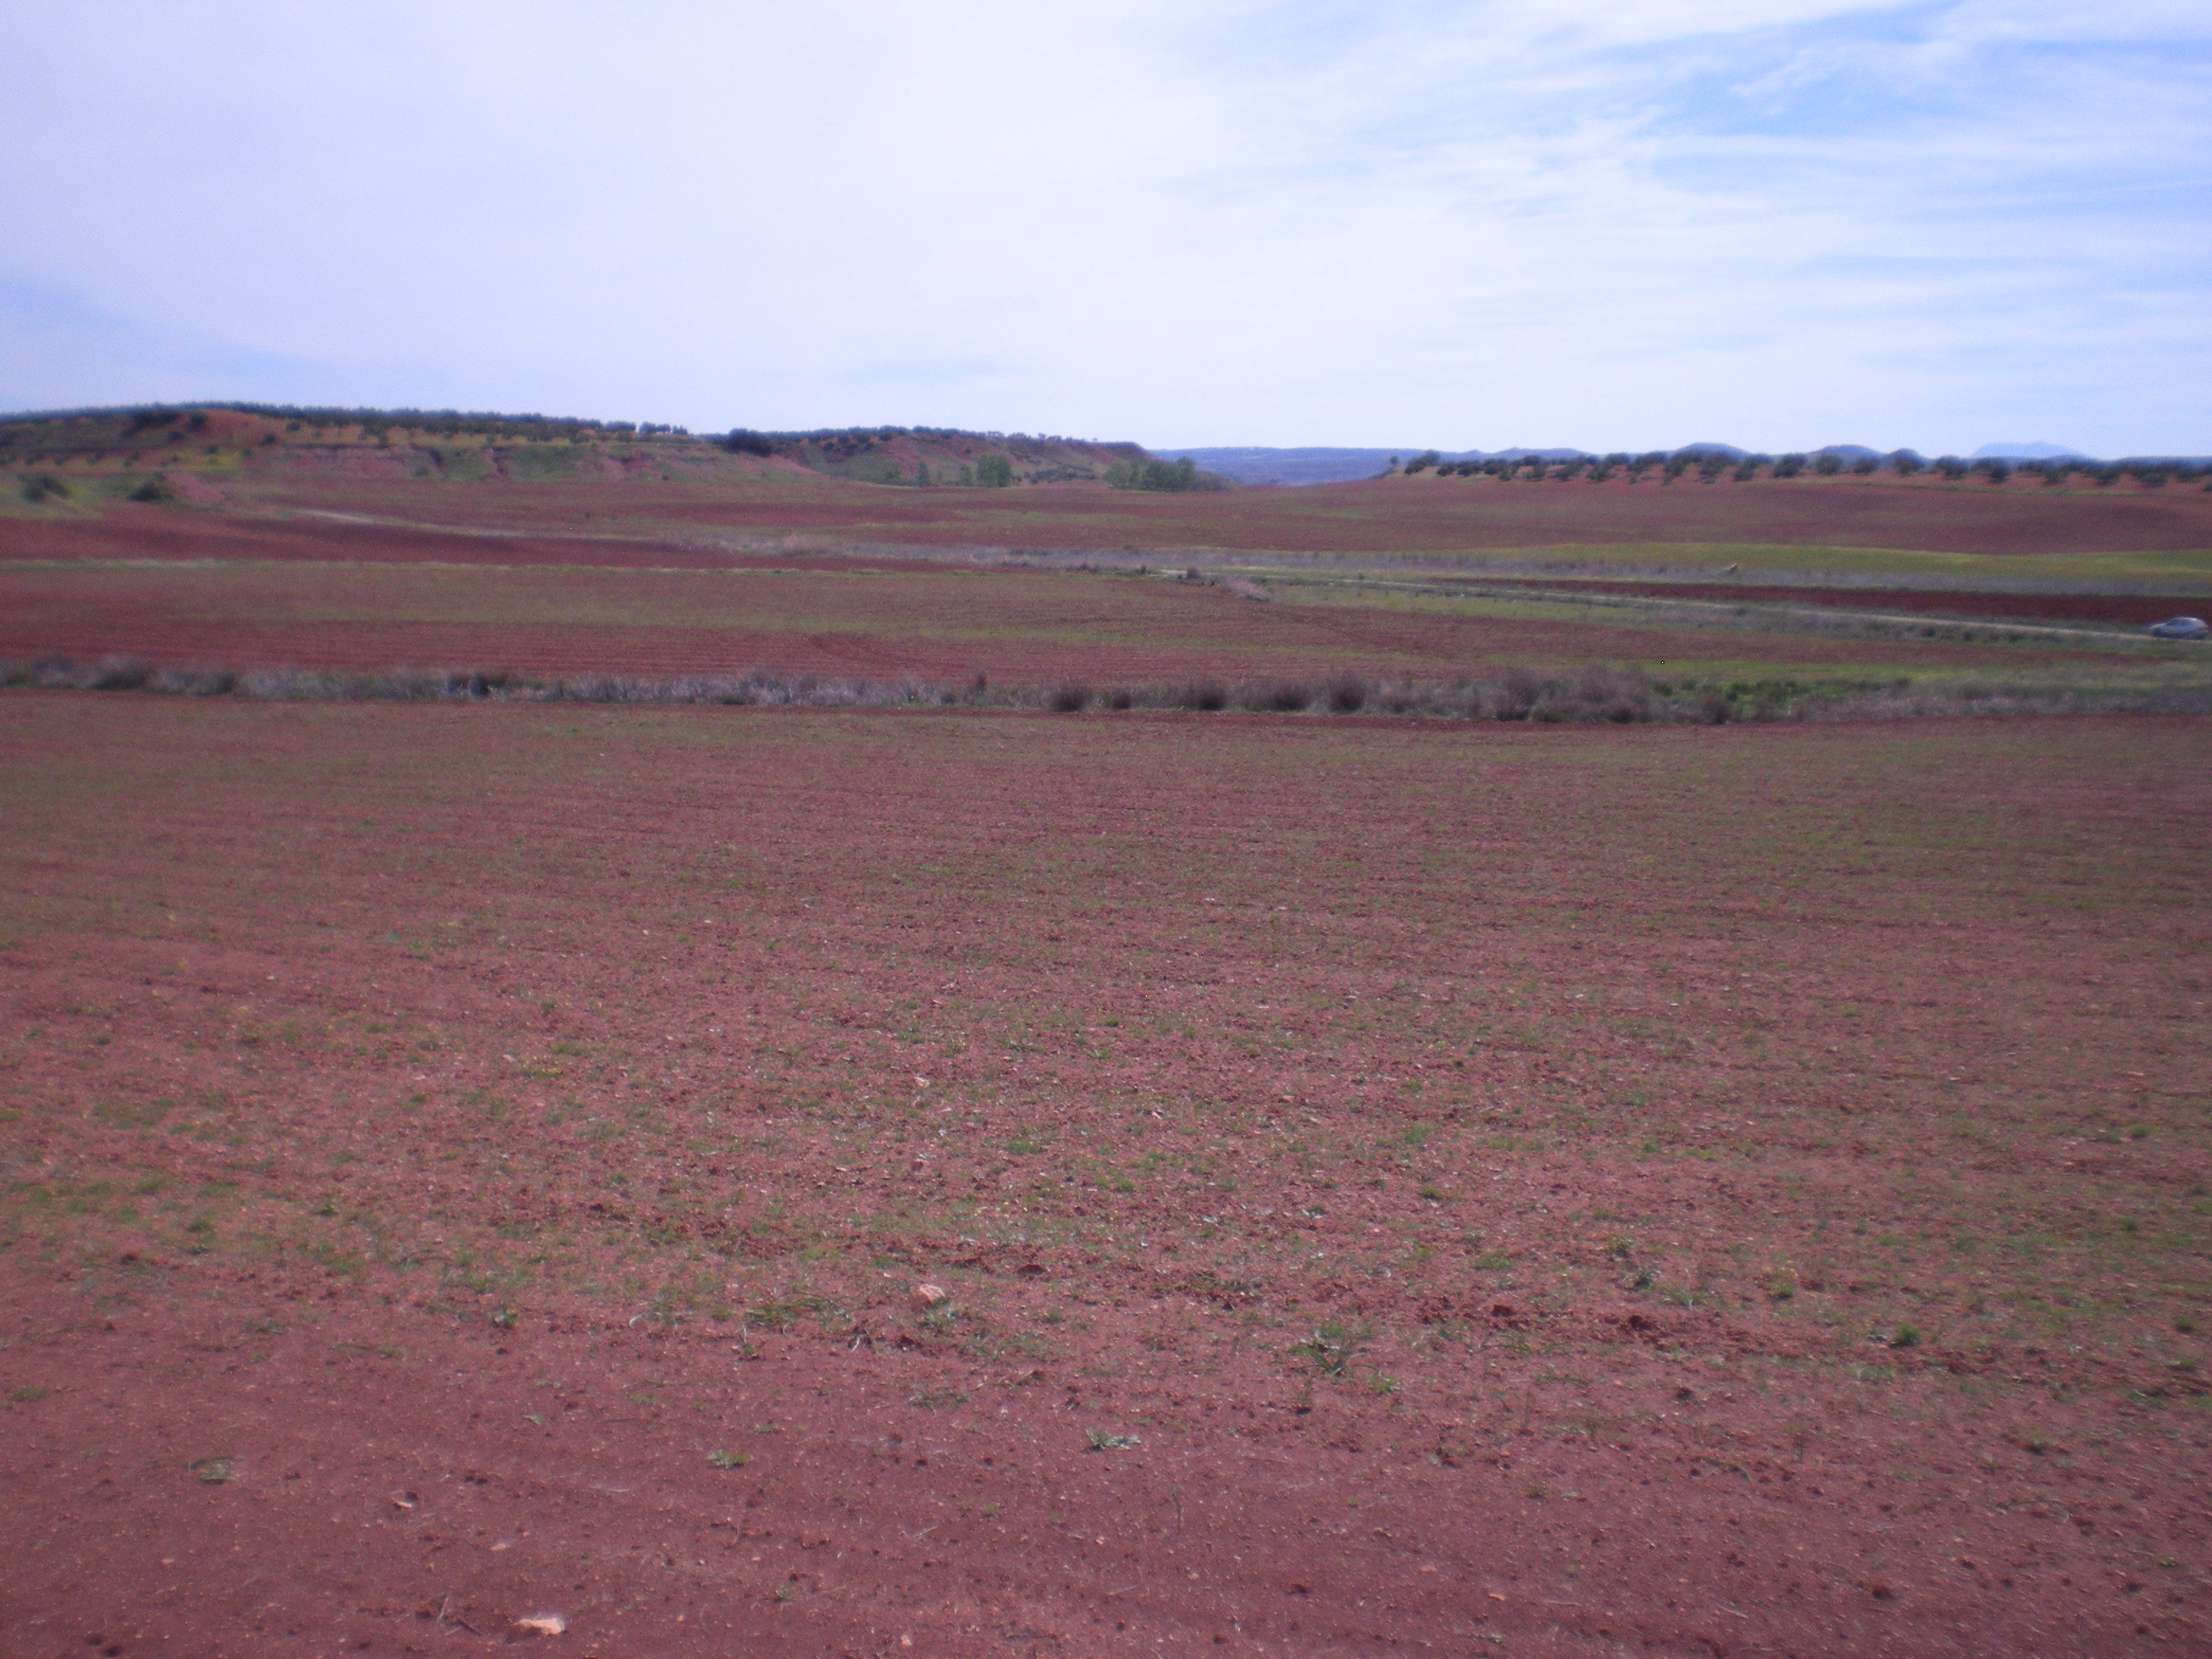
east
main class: Grassland
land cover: Grassland without tree/shrub cover
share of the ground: > 75 %
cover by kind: herbaceous plants 95 %, unconsolidated bare surface 5 %
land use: Semi-natural and natural areas not in use
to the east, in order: Grassland without tree/shrub cover; Spontaneously vegetated surfaces; Grass margins; Rivers and streams; Grass margins; Spontaneously vegetated surfaces; Grass margins; Rivers and streams; Grassland without tree/shrub cover; Grass margins; Tracks; Spontaneously vegetated surfaces
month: April
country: ES
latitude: 38.6088
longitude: -3.0161
